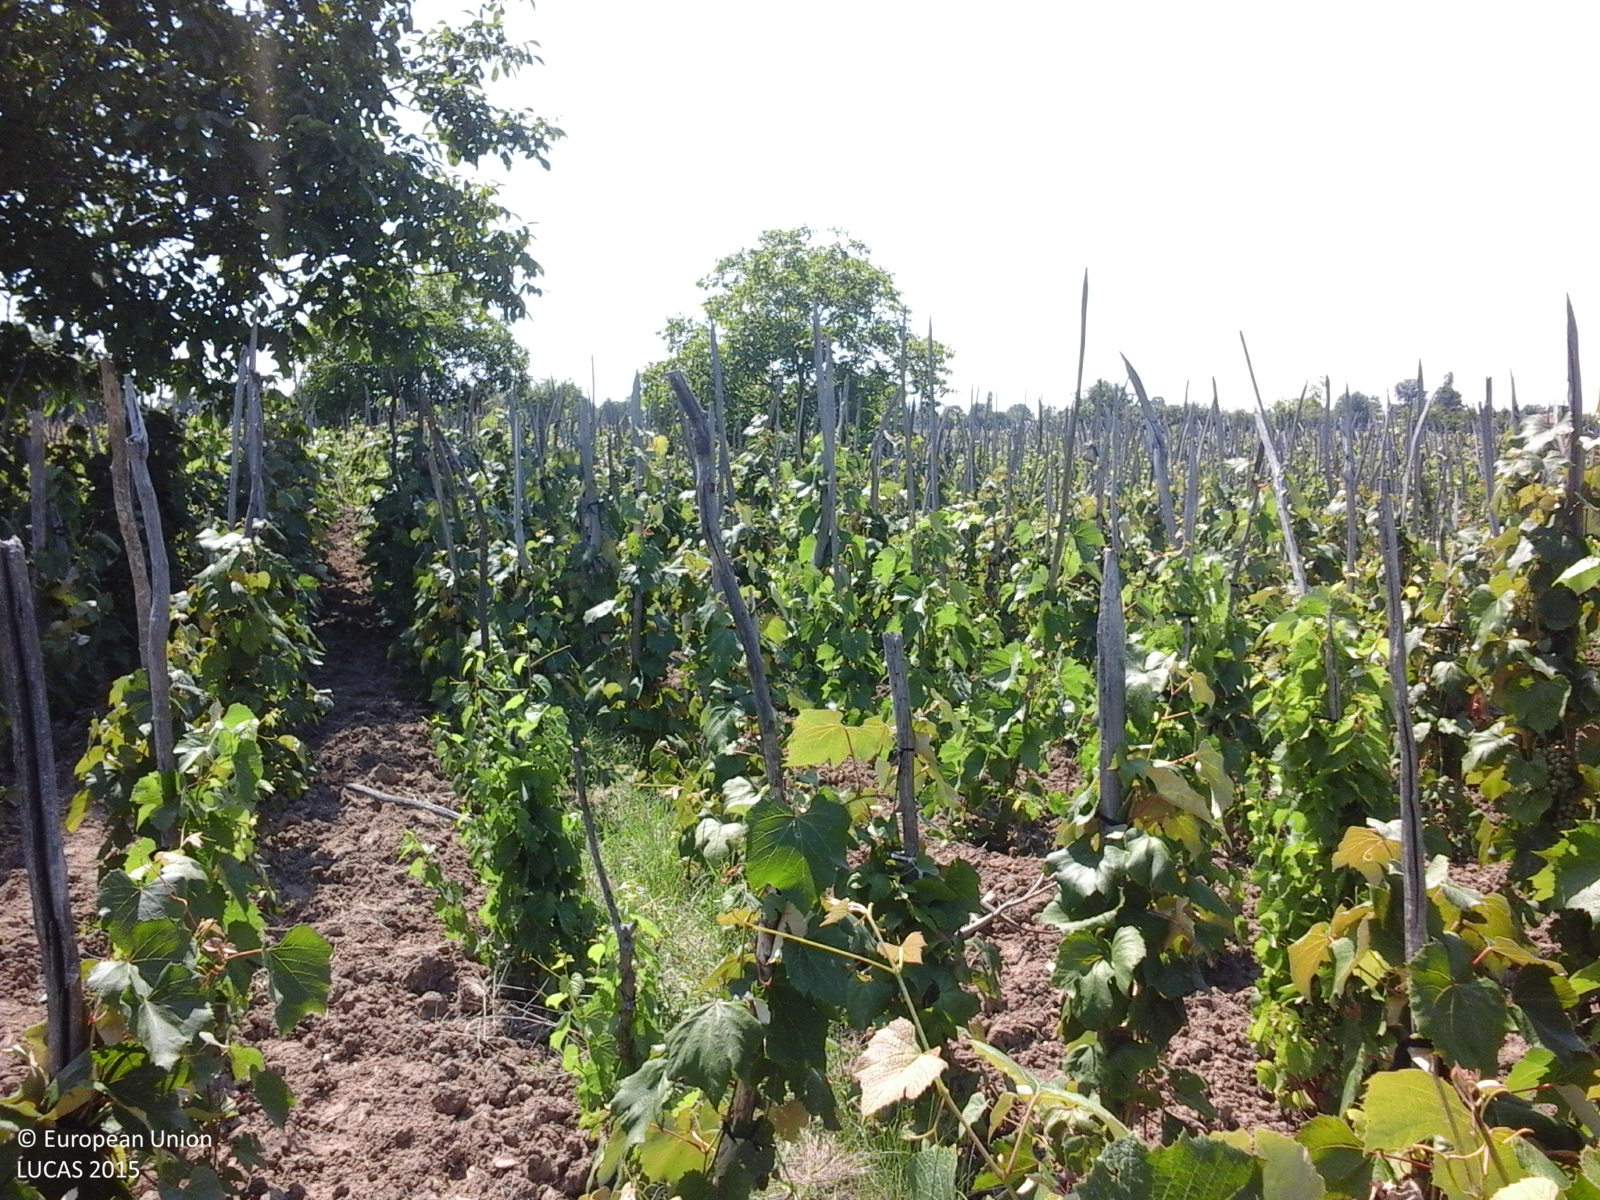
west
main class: Cropland
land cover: Vineyards
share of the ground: 50 - 75 %
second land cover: Other bare soil
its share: > 75 %
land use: Agriculture (excluding fallow land and kitchen gardens)
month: July
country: RO
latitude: 44.4446
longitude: 24.4824
